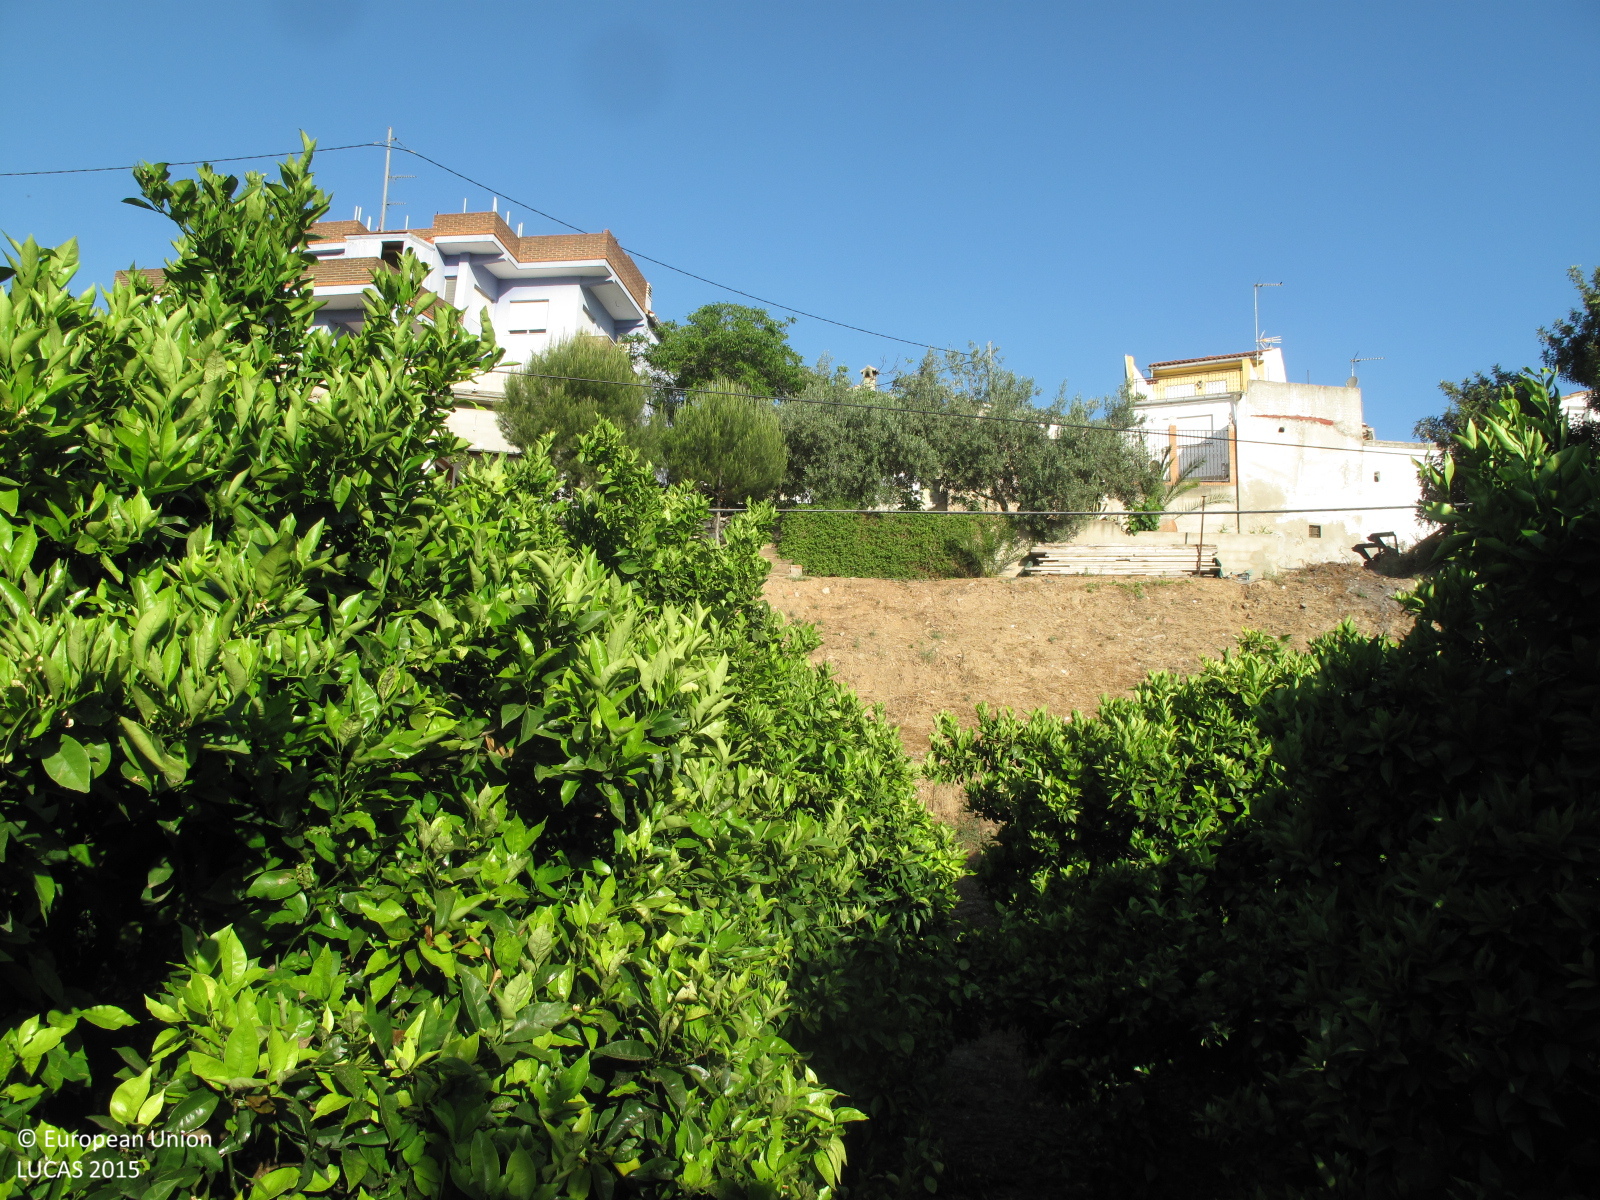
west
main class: Cropland
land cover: Oranges
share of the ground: > 75 %
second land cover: Other bare soil
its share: > 75 %
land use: Agriculture (excluding fallow land and kitchen gardens)
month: May
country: ES
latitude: 38.9848
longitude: -0.5558
